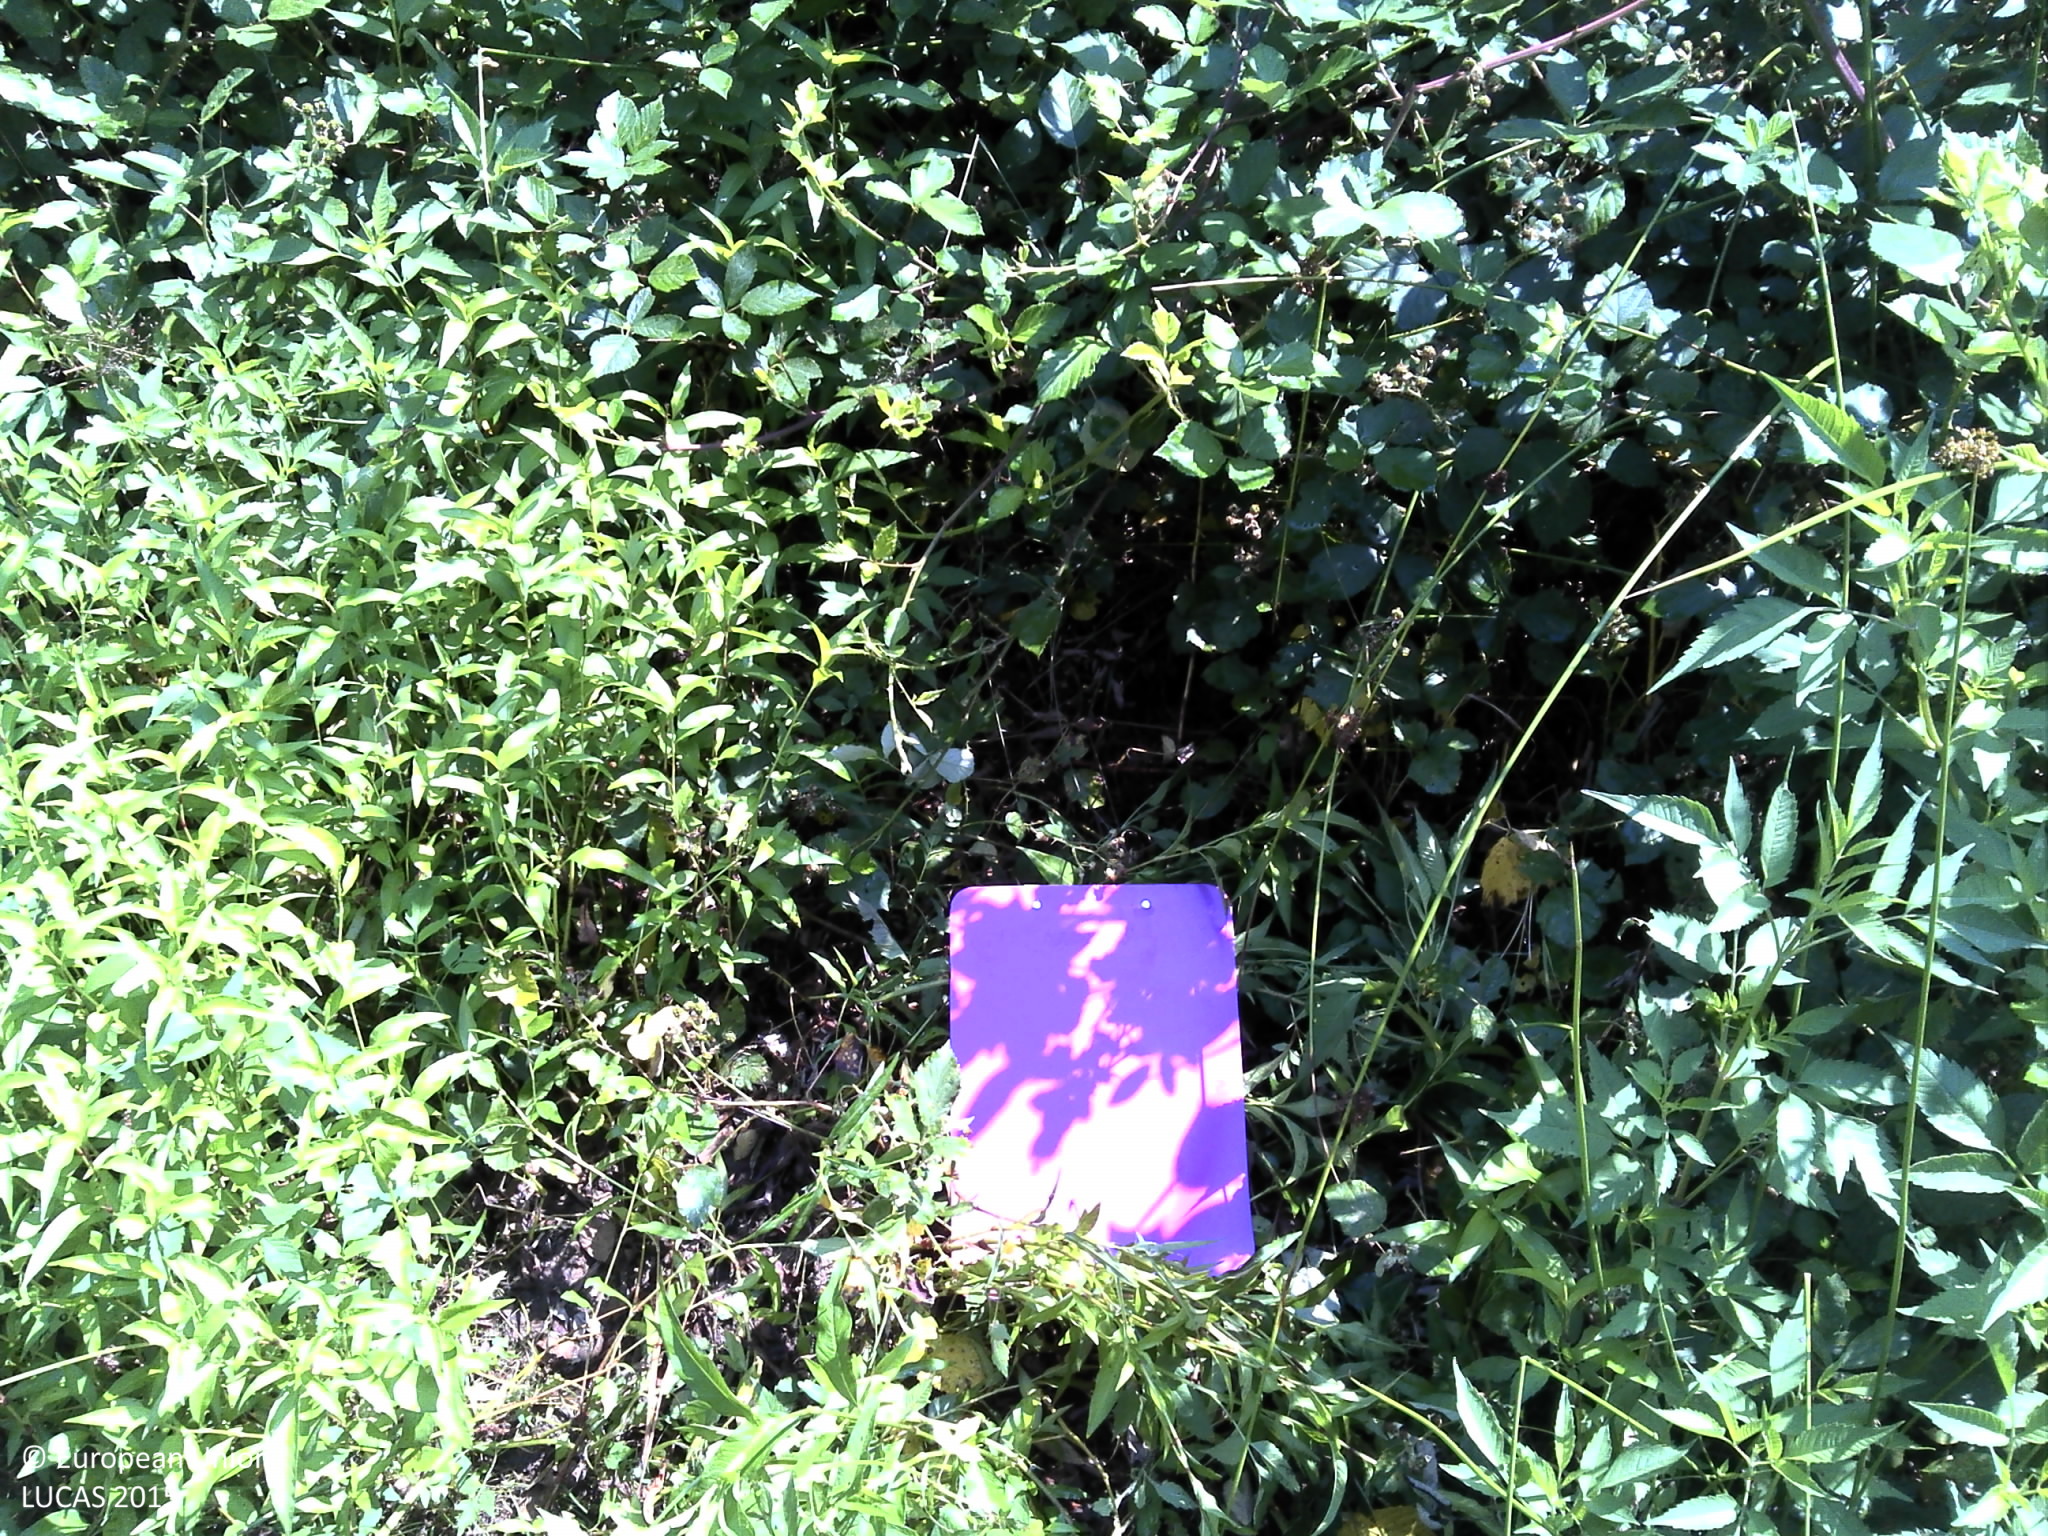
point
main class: Shrubland
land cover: Shrubland with sparse tree cover
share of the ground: > 75 %
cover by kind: shrubs 95 %, broadleaved forest trees 5 %
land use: Forestry
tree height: < 5 m
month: July
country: HR
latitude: 45.5969
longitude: 16.7295
